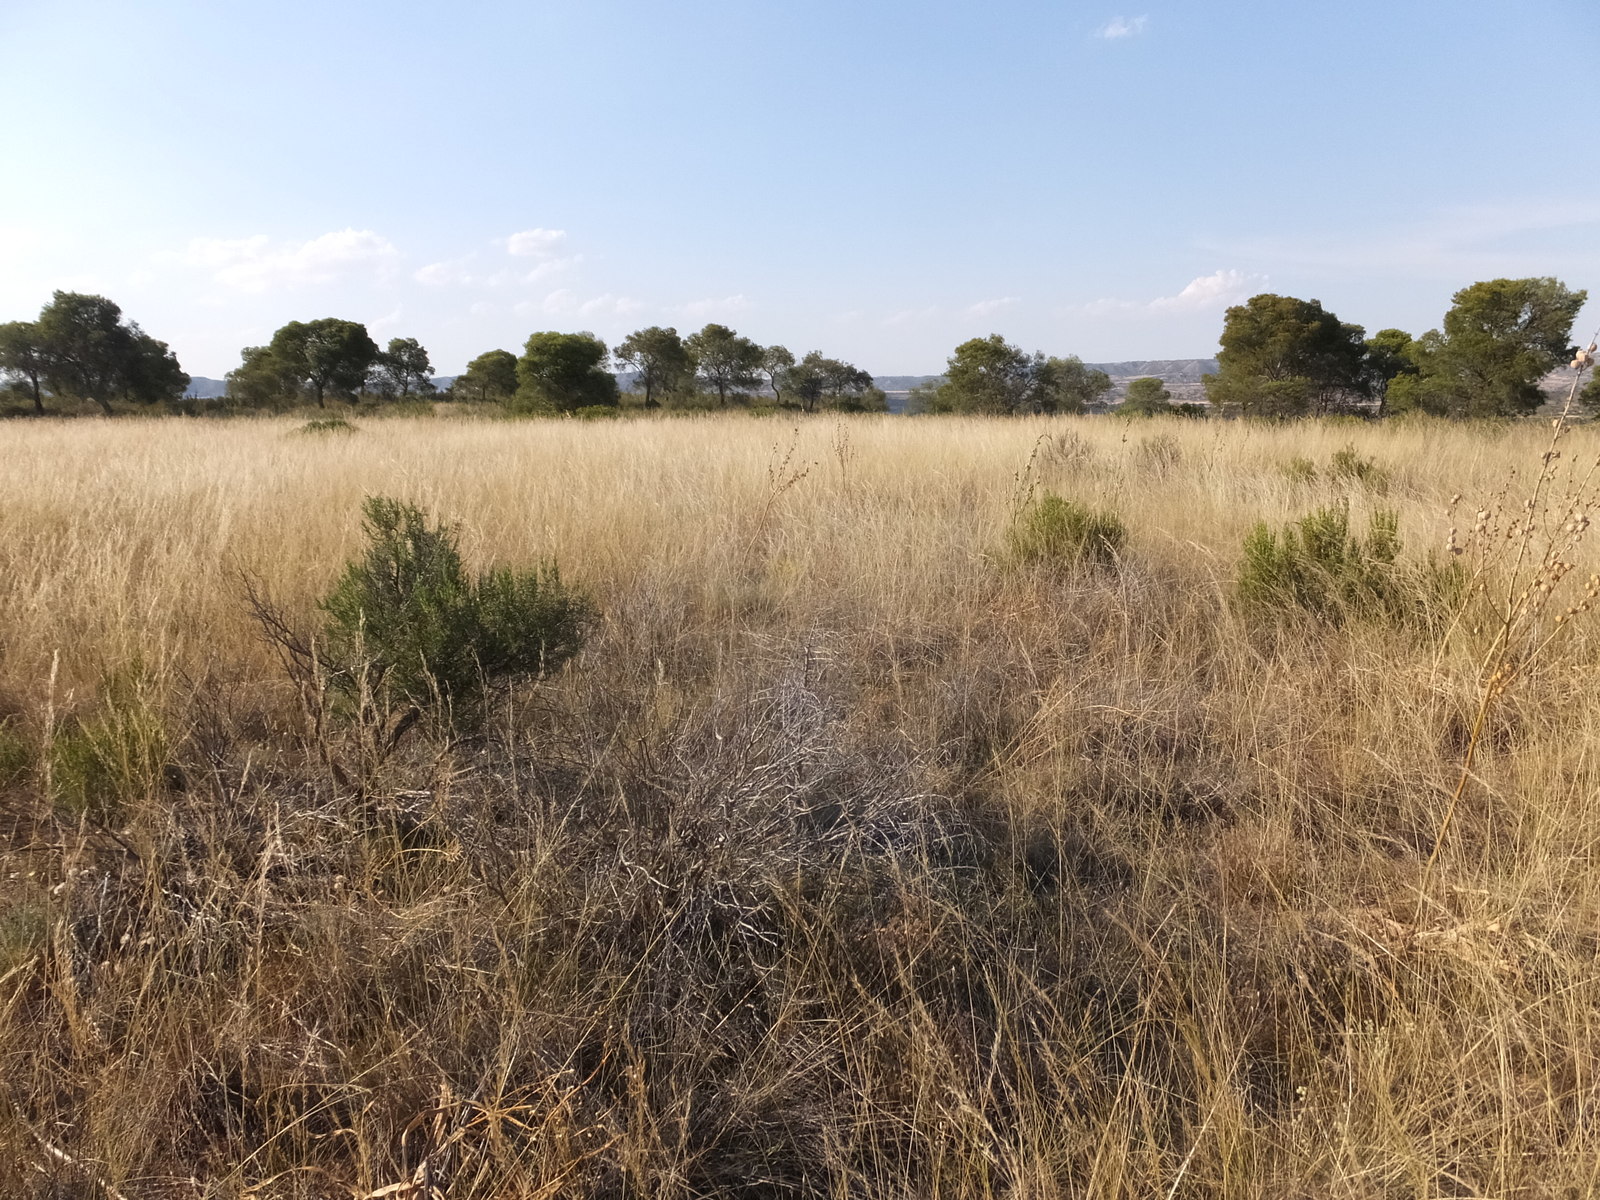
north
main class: Grassland
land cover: Grassland with sparse tree/shrub cover
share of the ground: > 75 %
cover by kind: herbaceous plants 85 %, shrubs 10 %, coniferous forest trees 5 %
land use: Abandoned areas
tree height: > 5 m
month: June
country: ES
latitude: 41.2779
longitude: -0.2456
